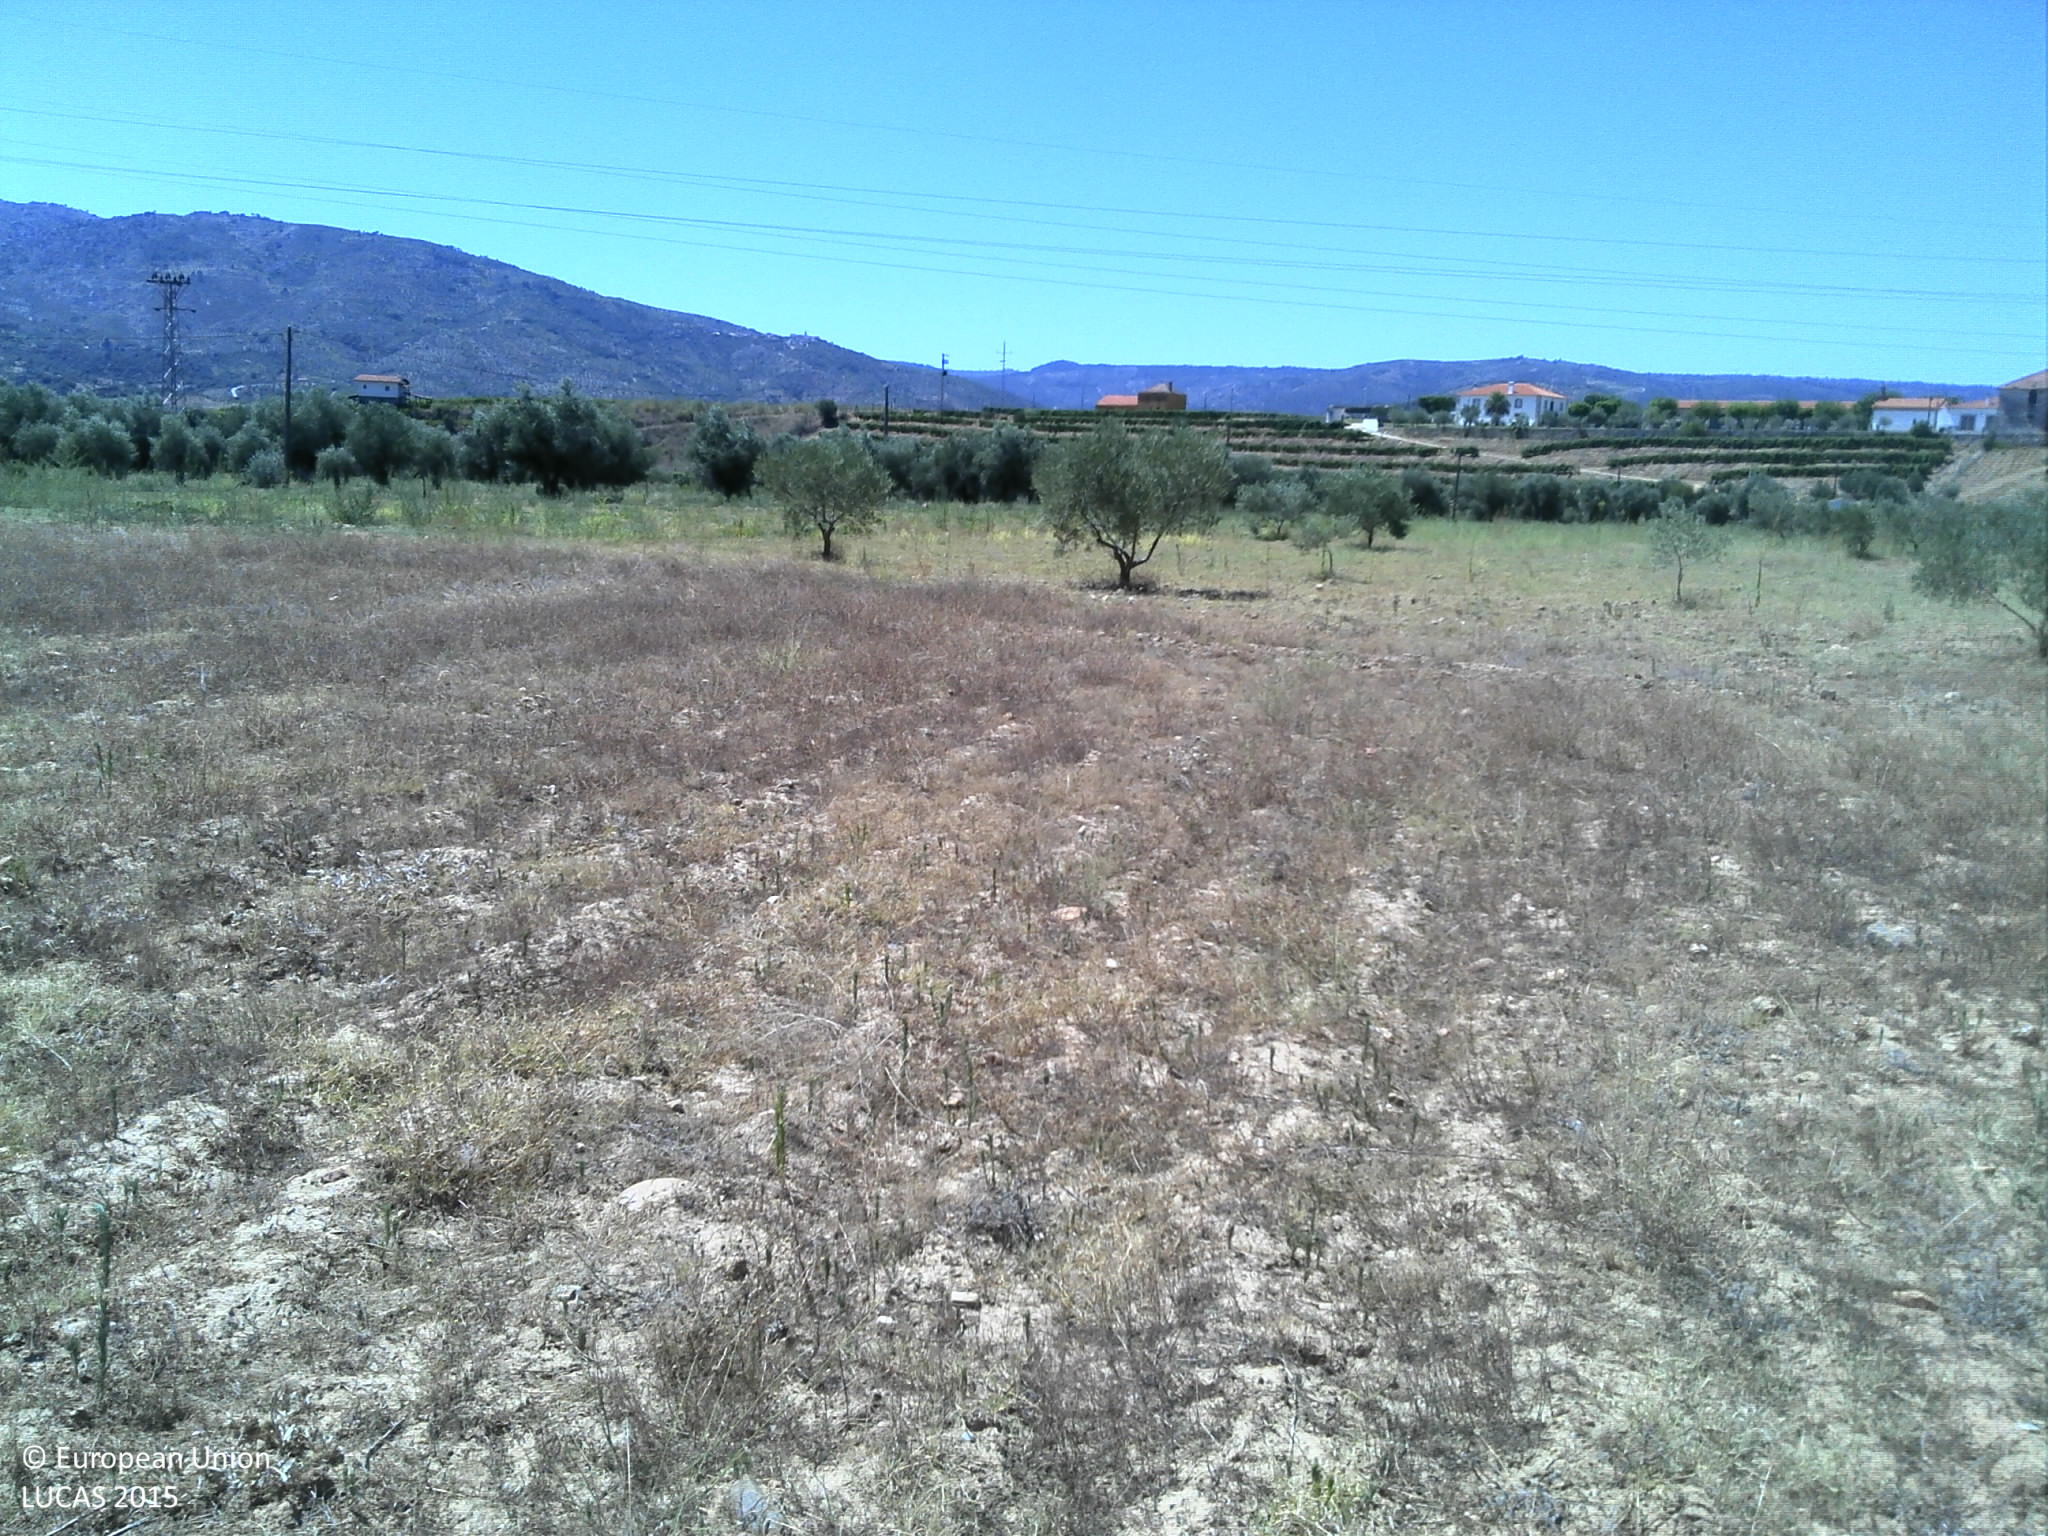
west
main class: Grassland
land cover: Spontaneously vegetated surfaces
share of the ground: 50 - 75 %
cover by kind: herbaceous plants 60 %, unconsolidated bare surface 40 %
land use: Fallow land
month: July
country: PT
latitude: 41.2436
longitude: -7.0929
